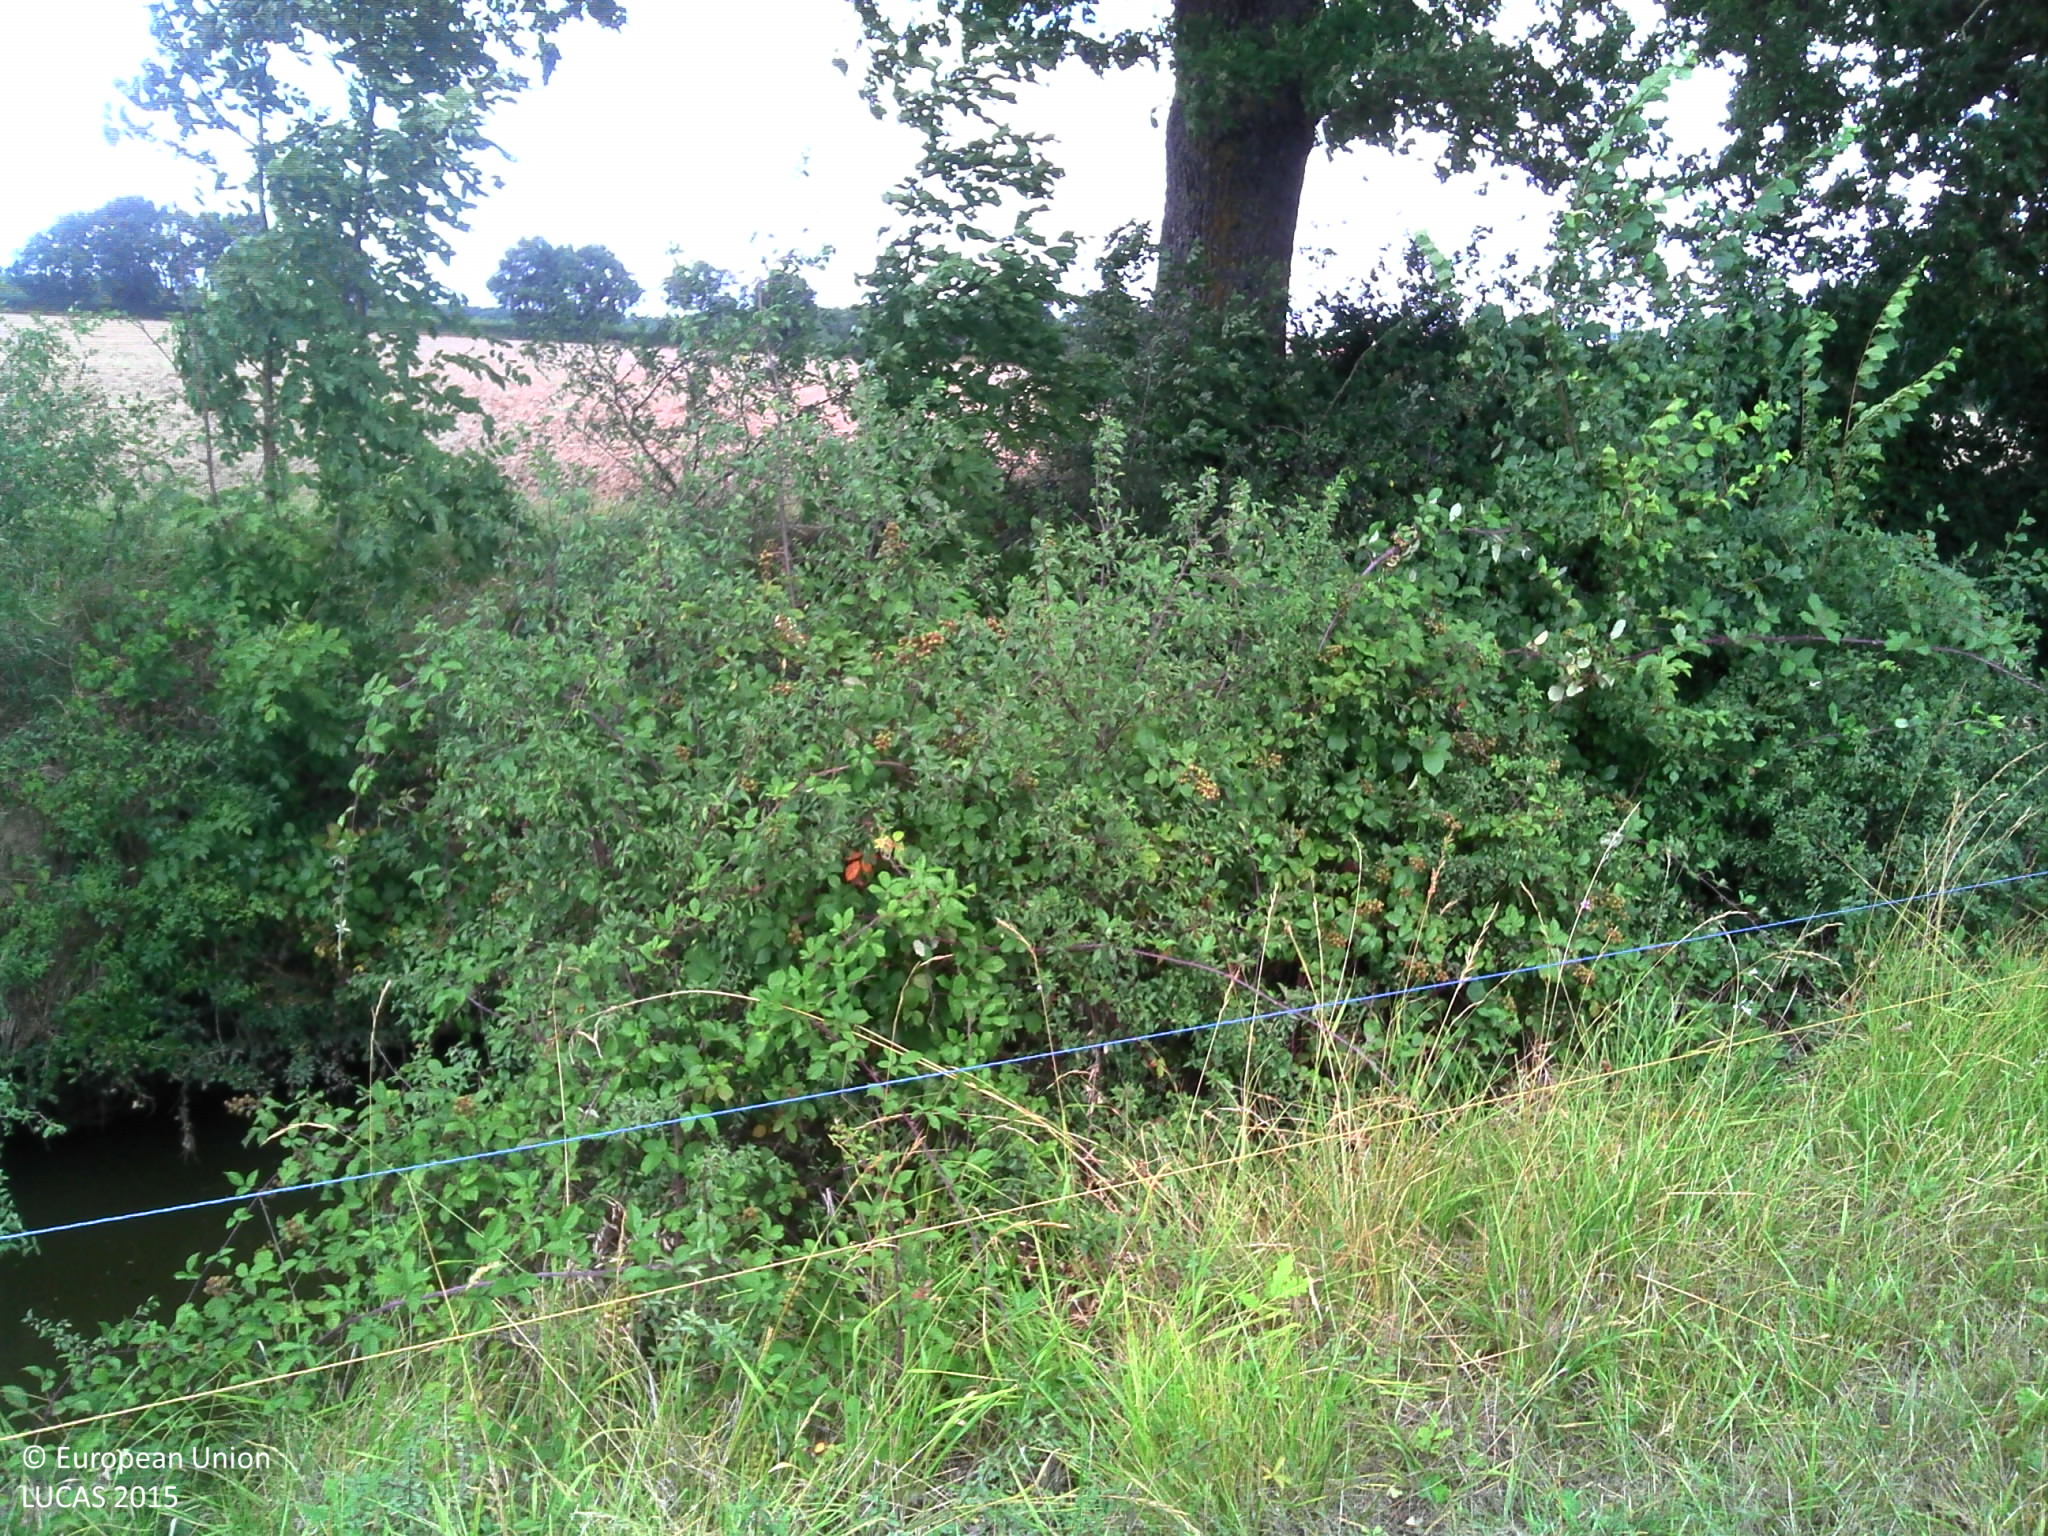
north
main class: Grassland
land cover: Grassland without tree/shrub cover
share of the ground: > 75 %
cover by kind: herbaceous plants 100 %
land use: Agriculture (excluding fallow land and kitchen gardens)
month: July
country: FR
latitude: 46.7594
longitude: 2.2816
